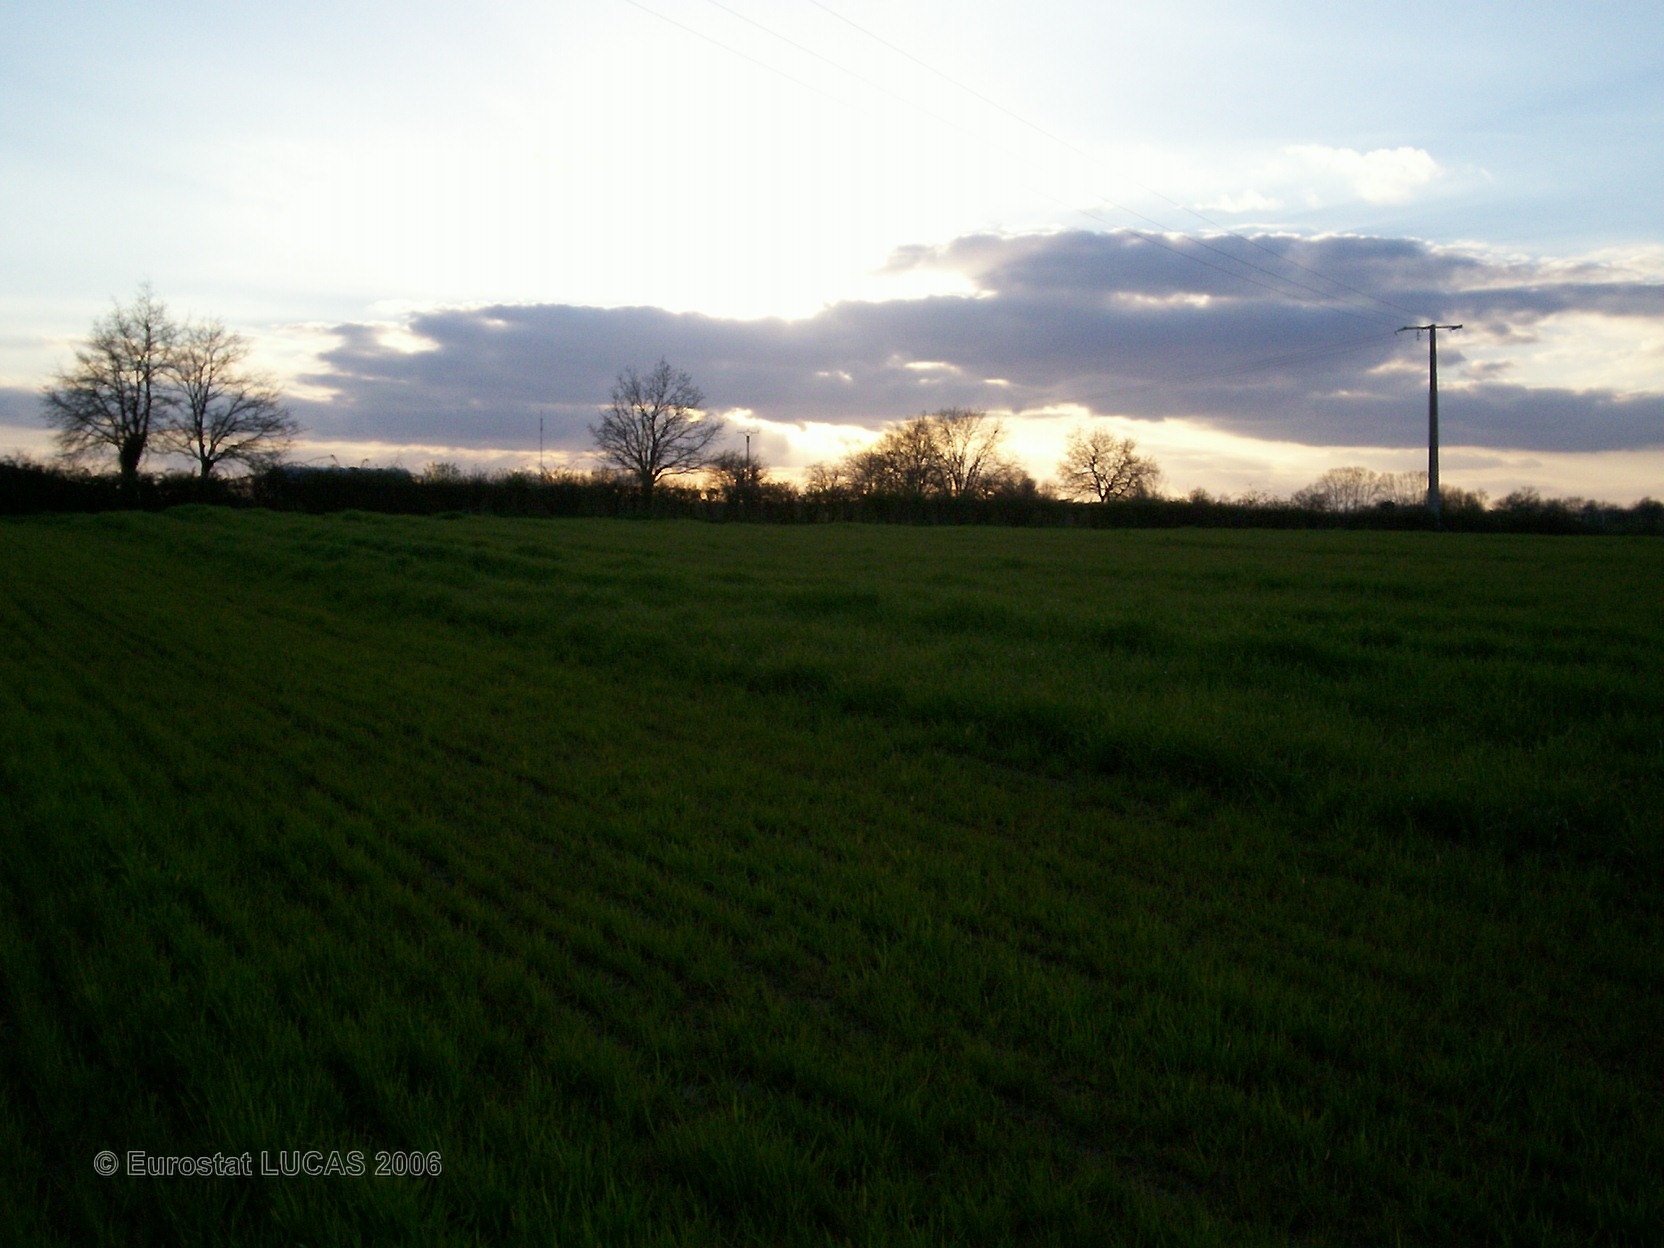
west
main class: Grassland
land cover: Grassland without tree/shrub cover
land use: Agriculture (excluding fallow land and kitchen gardens)
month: April
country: FR
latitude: 46.7598
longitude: -0.3035
